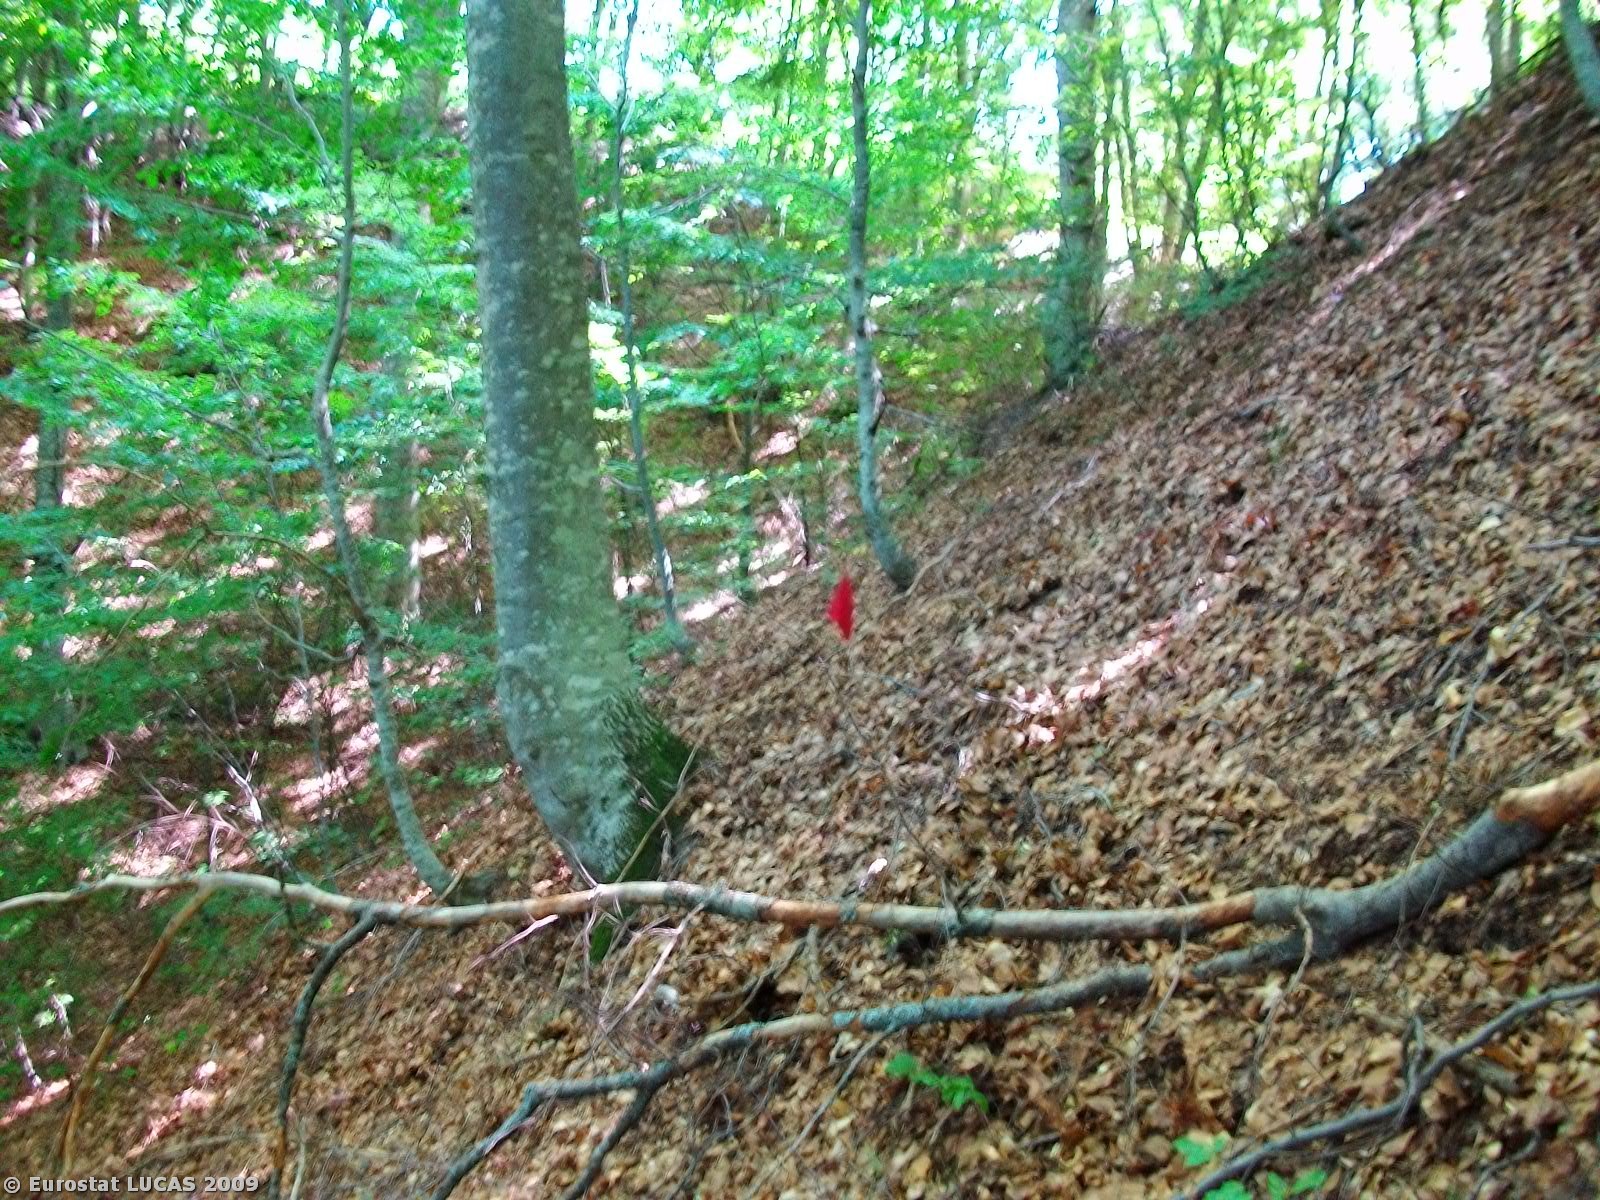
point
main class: Woodland
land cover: Broadleaved woodland
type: thermophilous deciduous forest
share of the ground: > 75 %
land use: Forestry
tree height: > 5 m
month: July
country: GR
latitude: 41.1799
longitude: 24.5197
